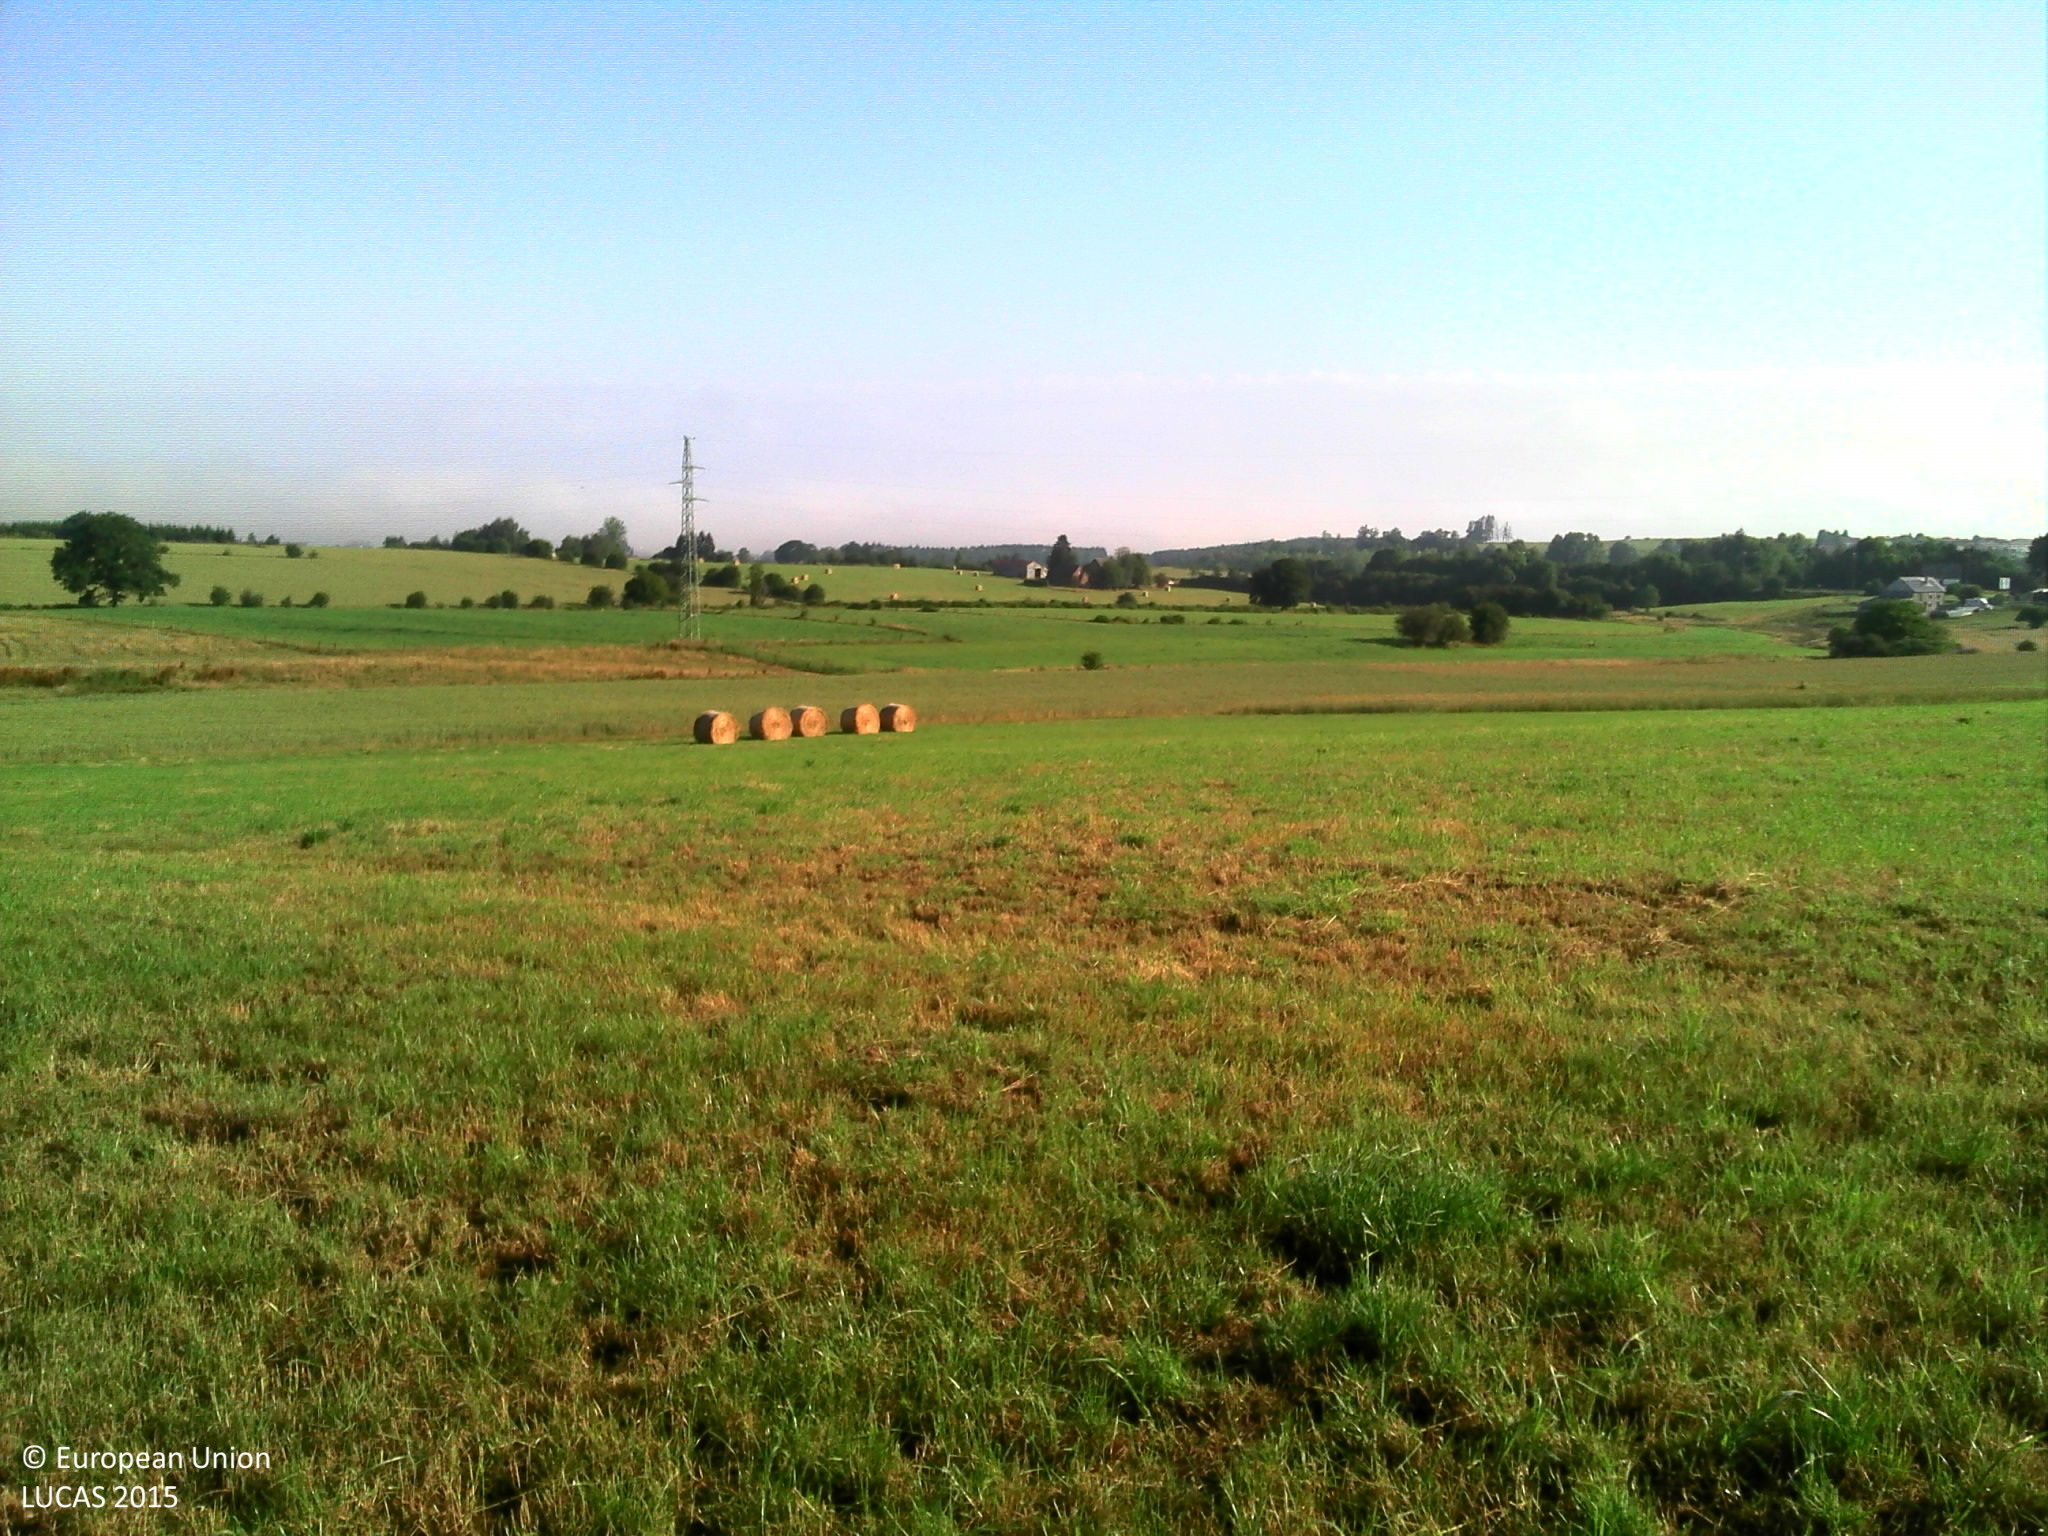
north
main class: Grassland
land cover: Grassland without tree/shrub cover
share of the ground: > 75 %
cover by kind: herbaceous plants 100 %
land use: Agriculture (excluding fallow land and kitchen gardens)
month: July
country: BE
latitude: 50.0105
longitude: 5.6309
